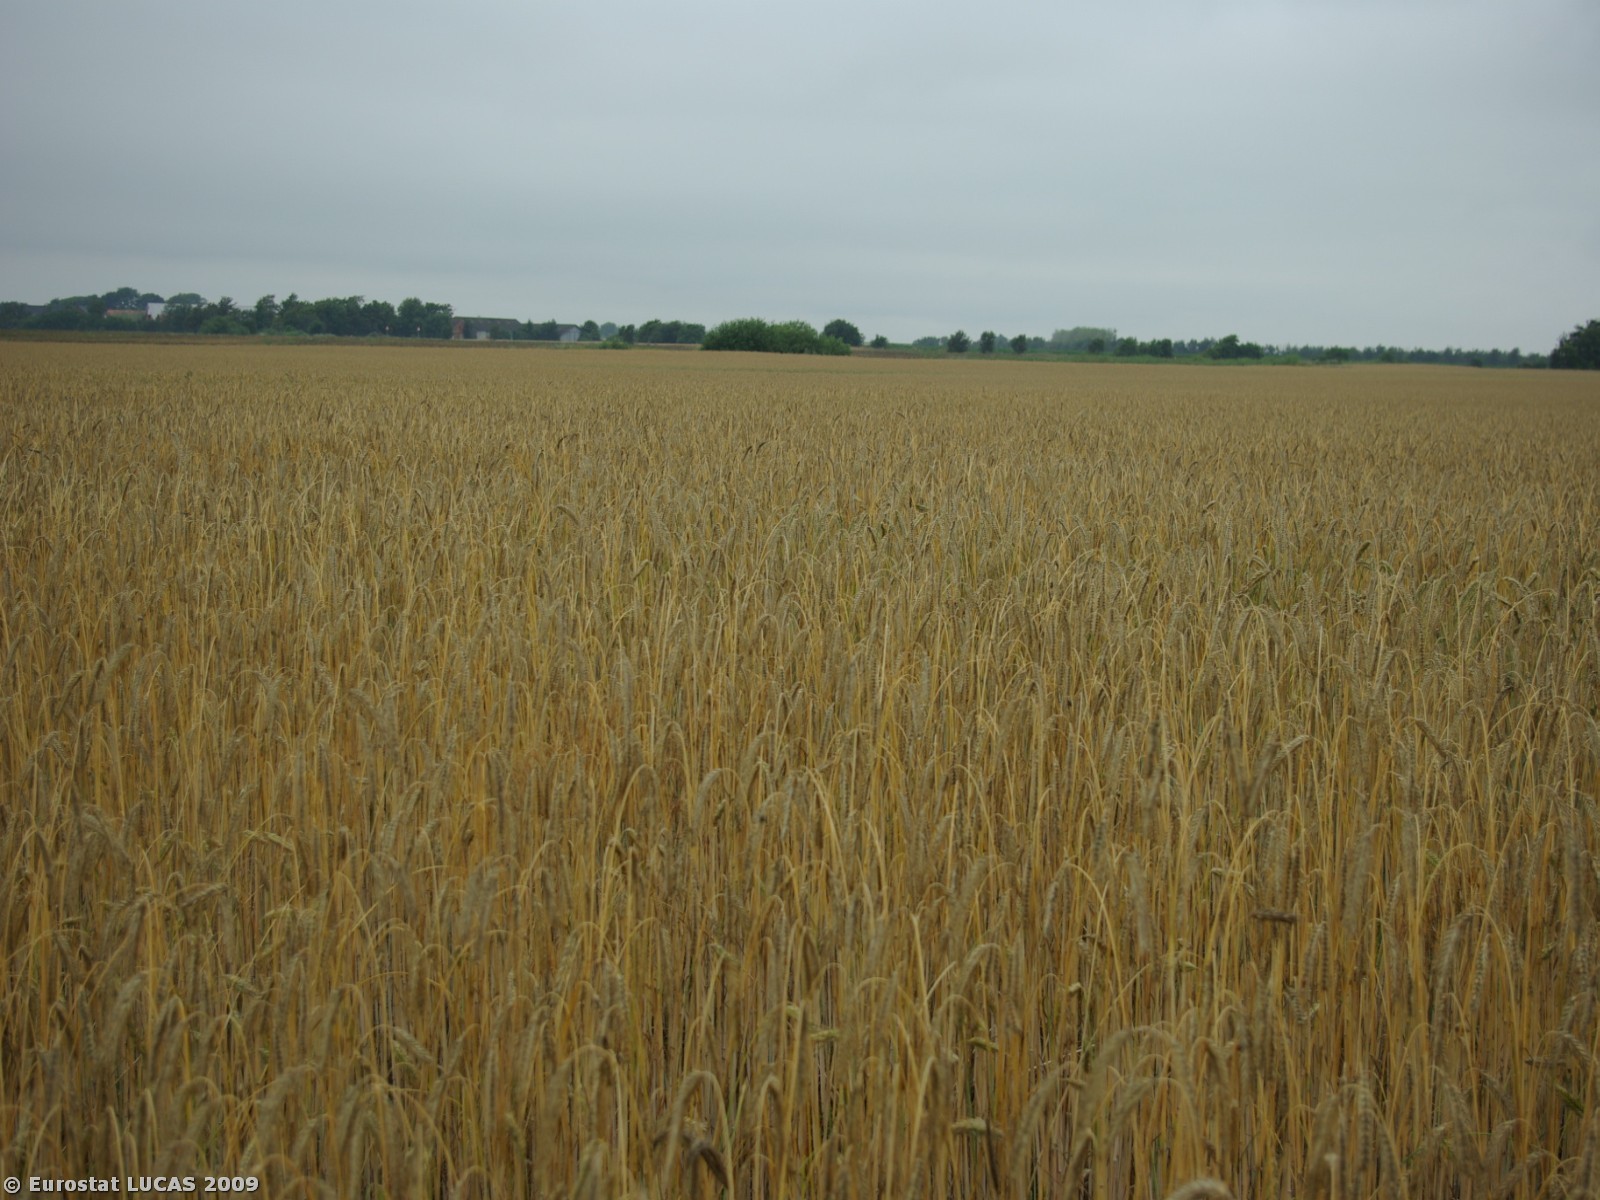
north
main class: Cropland
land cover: Rye
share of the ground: > 75 %
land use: Agriculture (excluding fallow land and kitchen gardens)
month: July
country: DK
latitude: 55.0669
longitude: 8.7326
